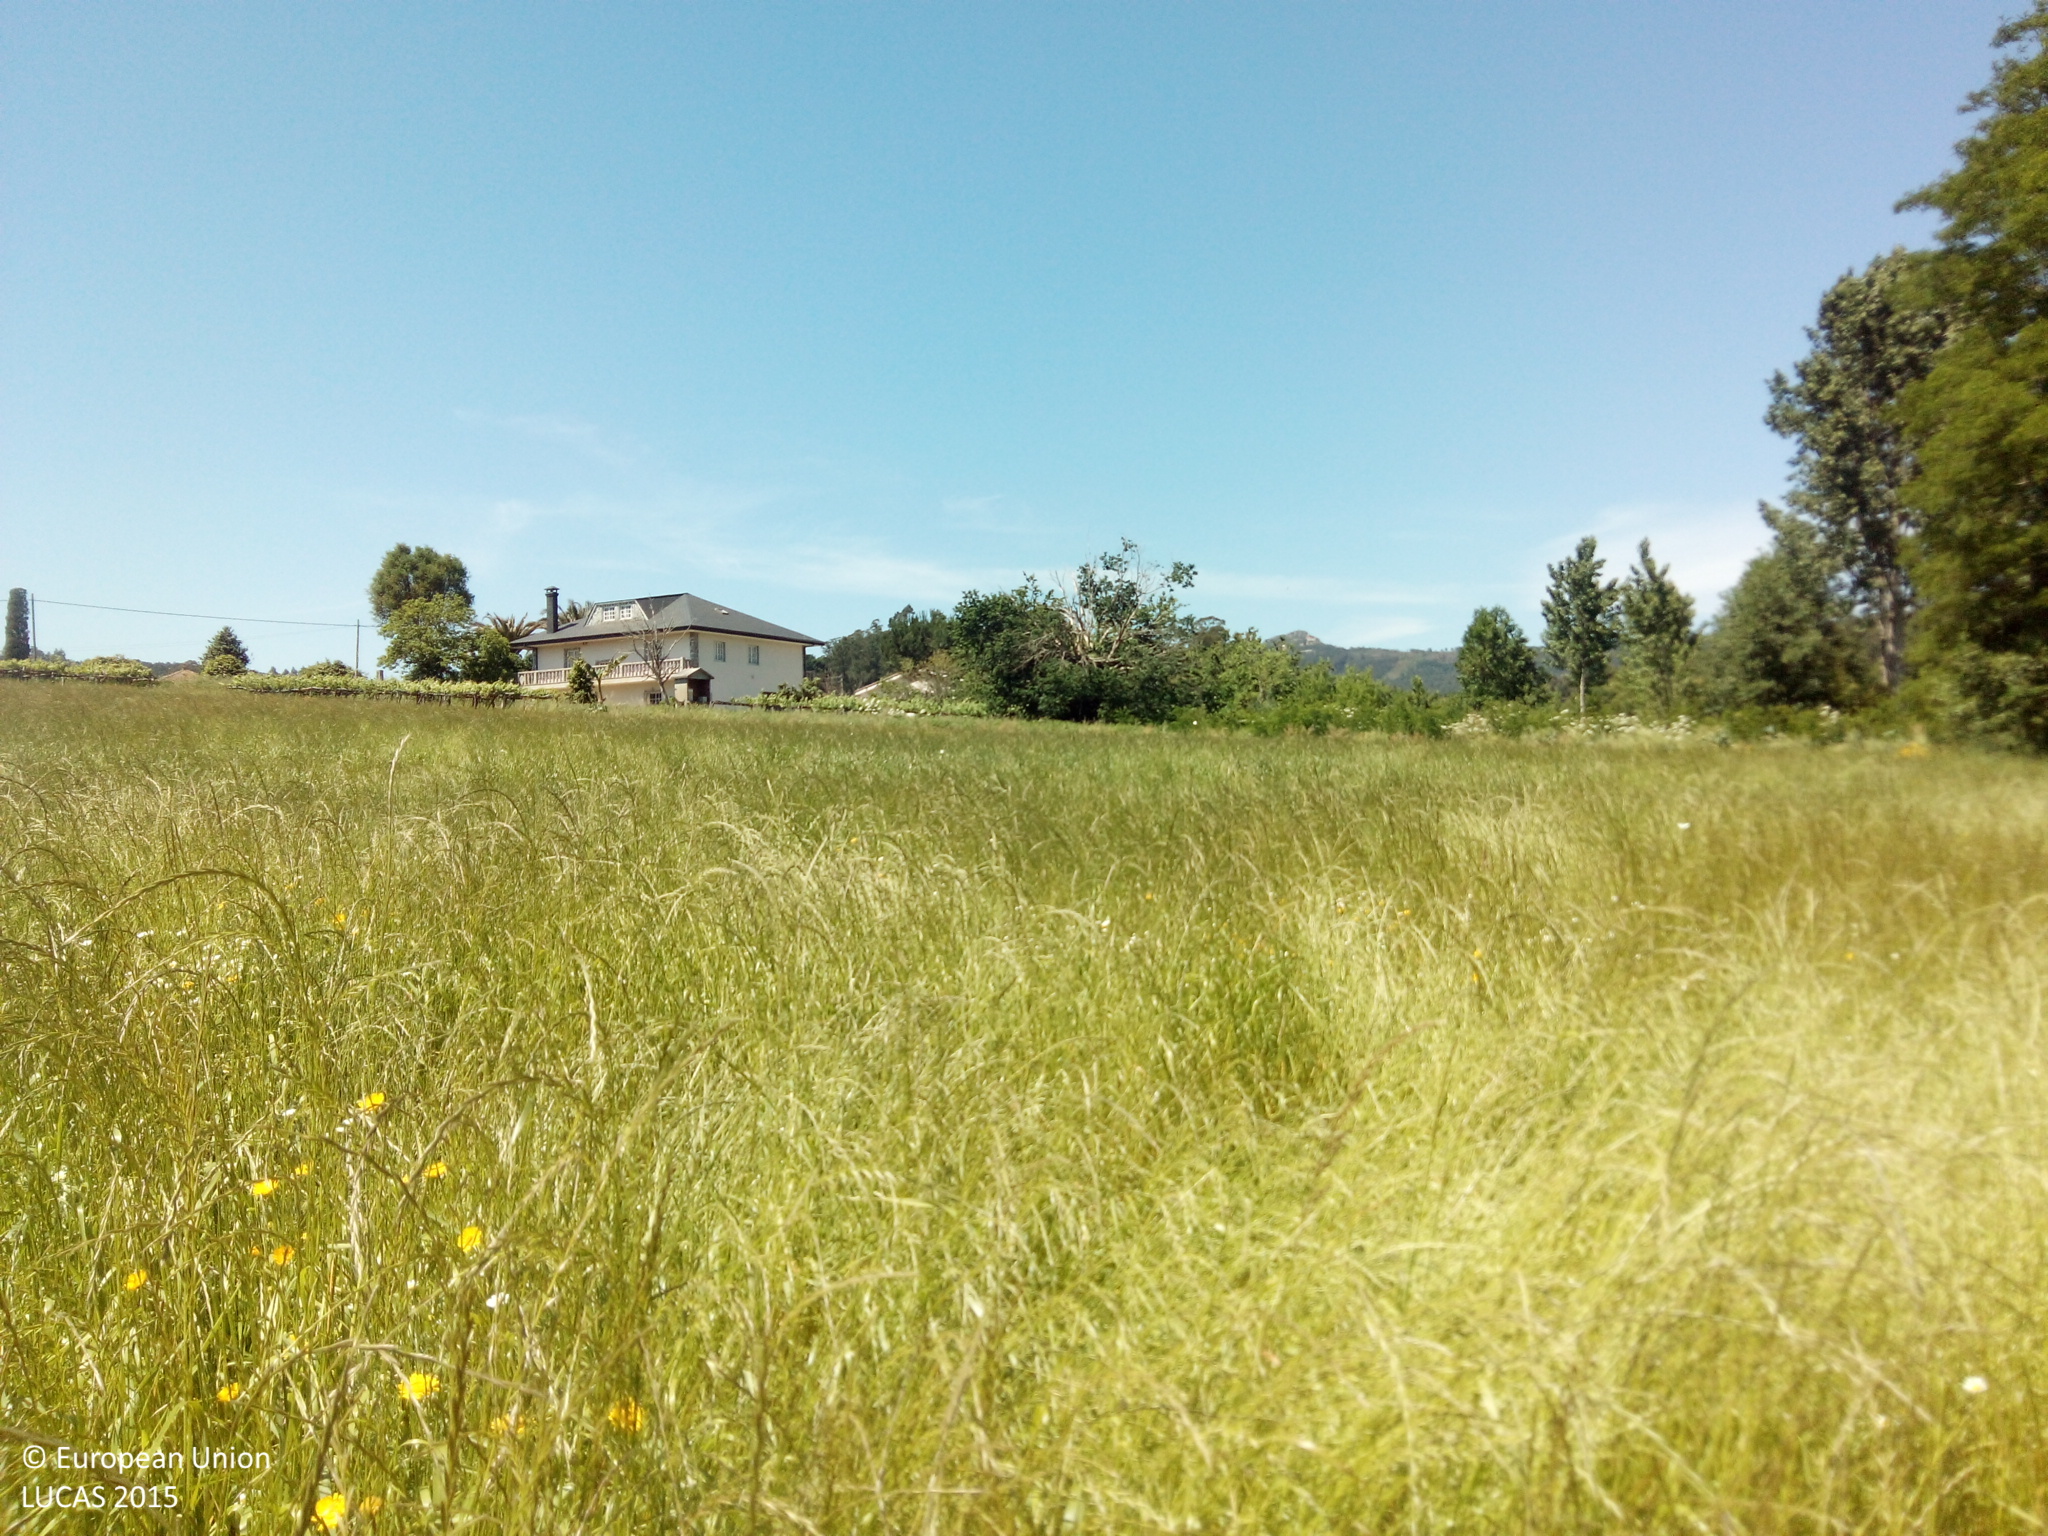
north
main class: Cropland
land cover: Temporary grasslands
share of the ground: > 75 %
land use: Agriculture (excluding fallow land and kitchen gardens)
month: May
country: ES
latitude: 42.7716
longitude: -8.4448
